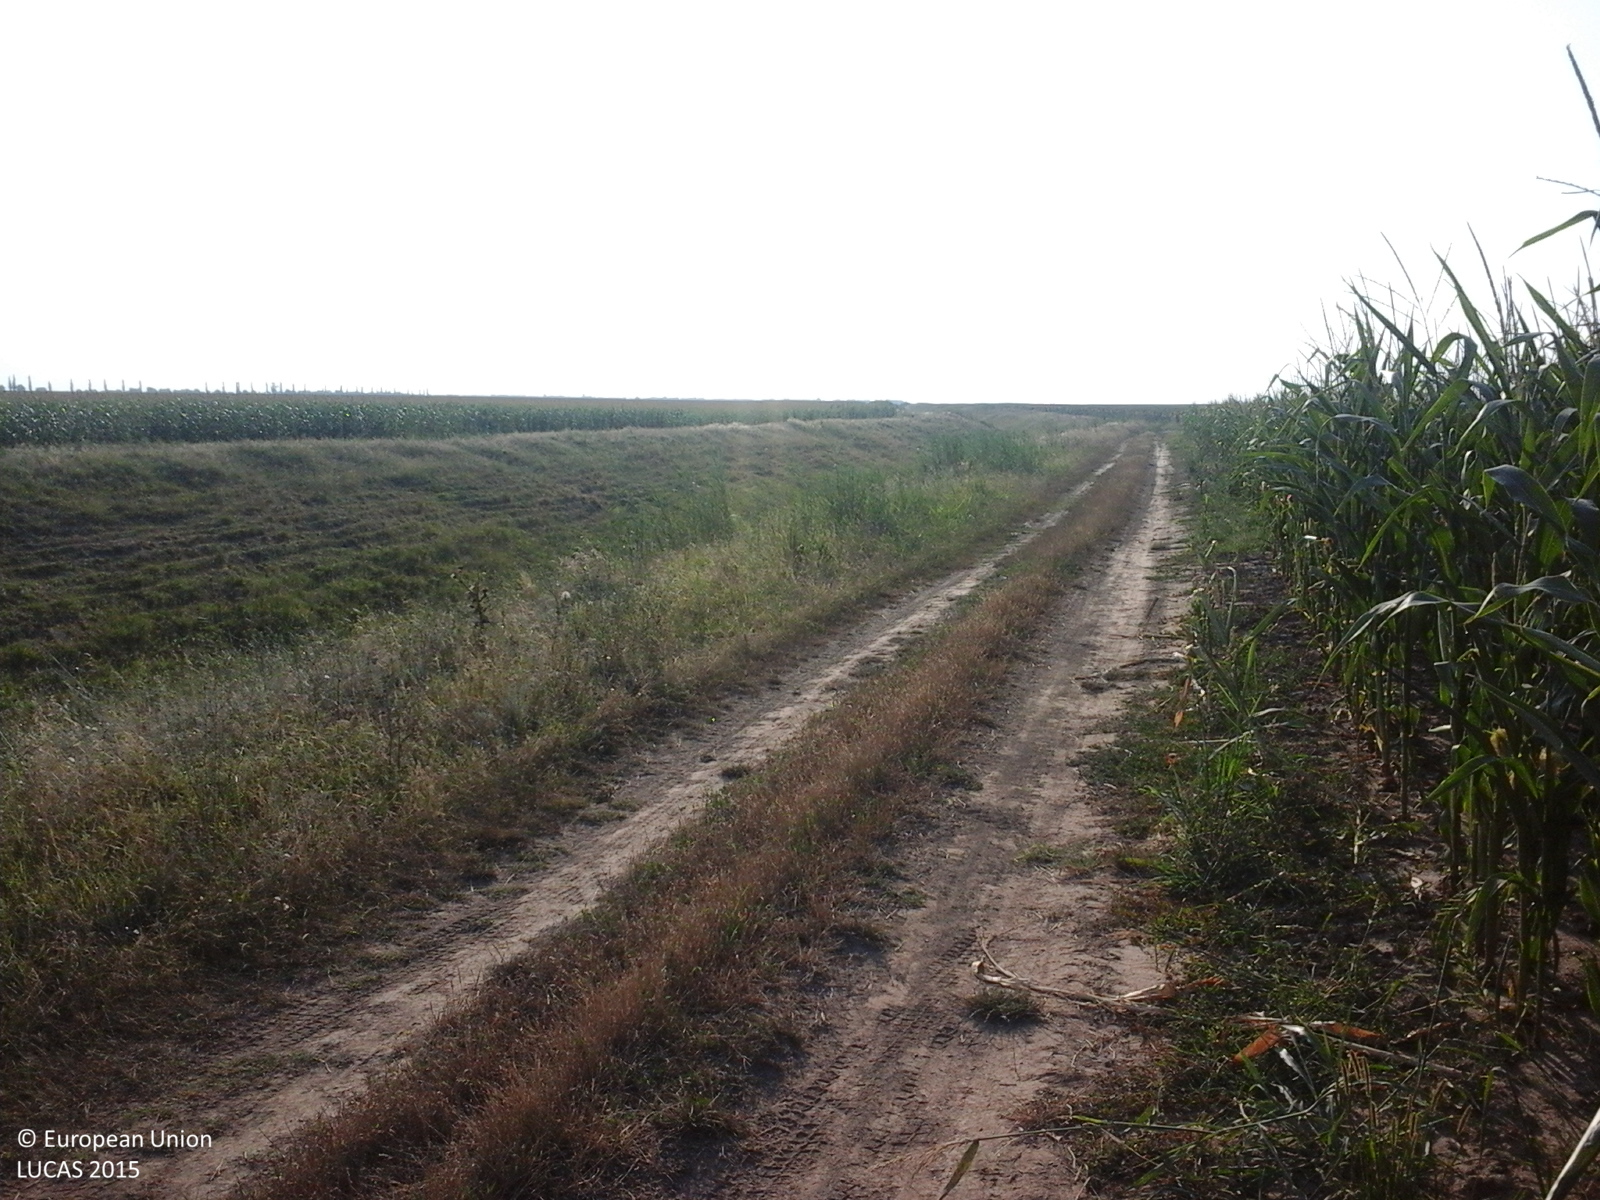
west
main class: Cropland
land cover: Maize
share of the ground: > 75 %
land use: Agriculture (excluding fallow land and kitchen gardens)
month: July
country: RO
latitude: 44.7770
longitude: 27.2102
